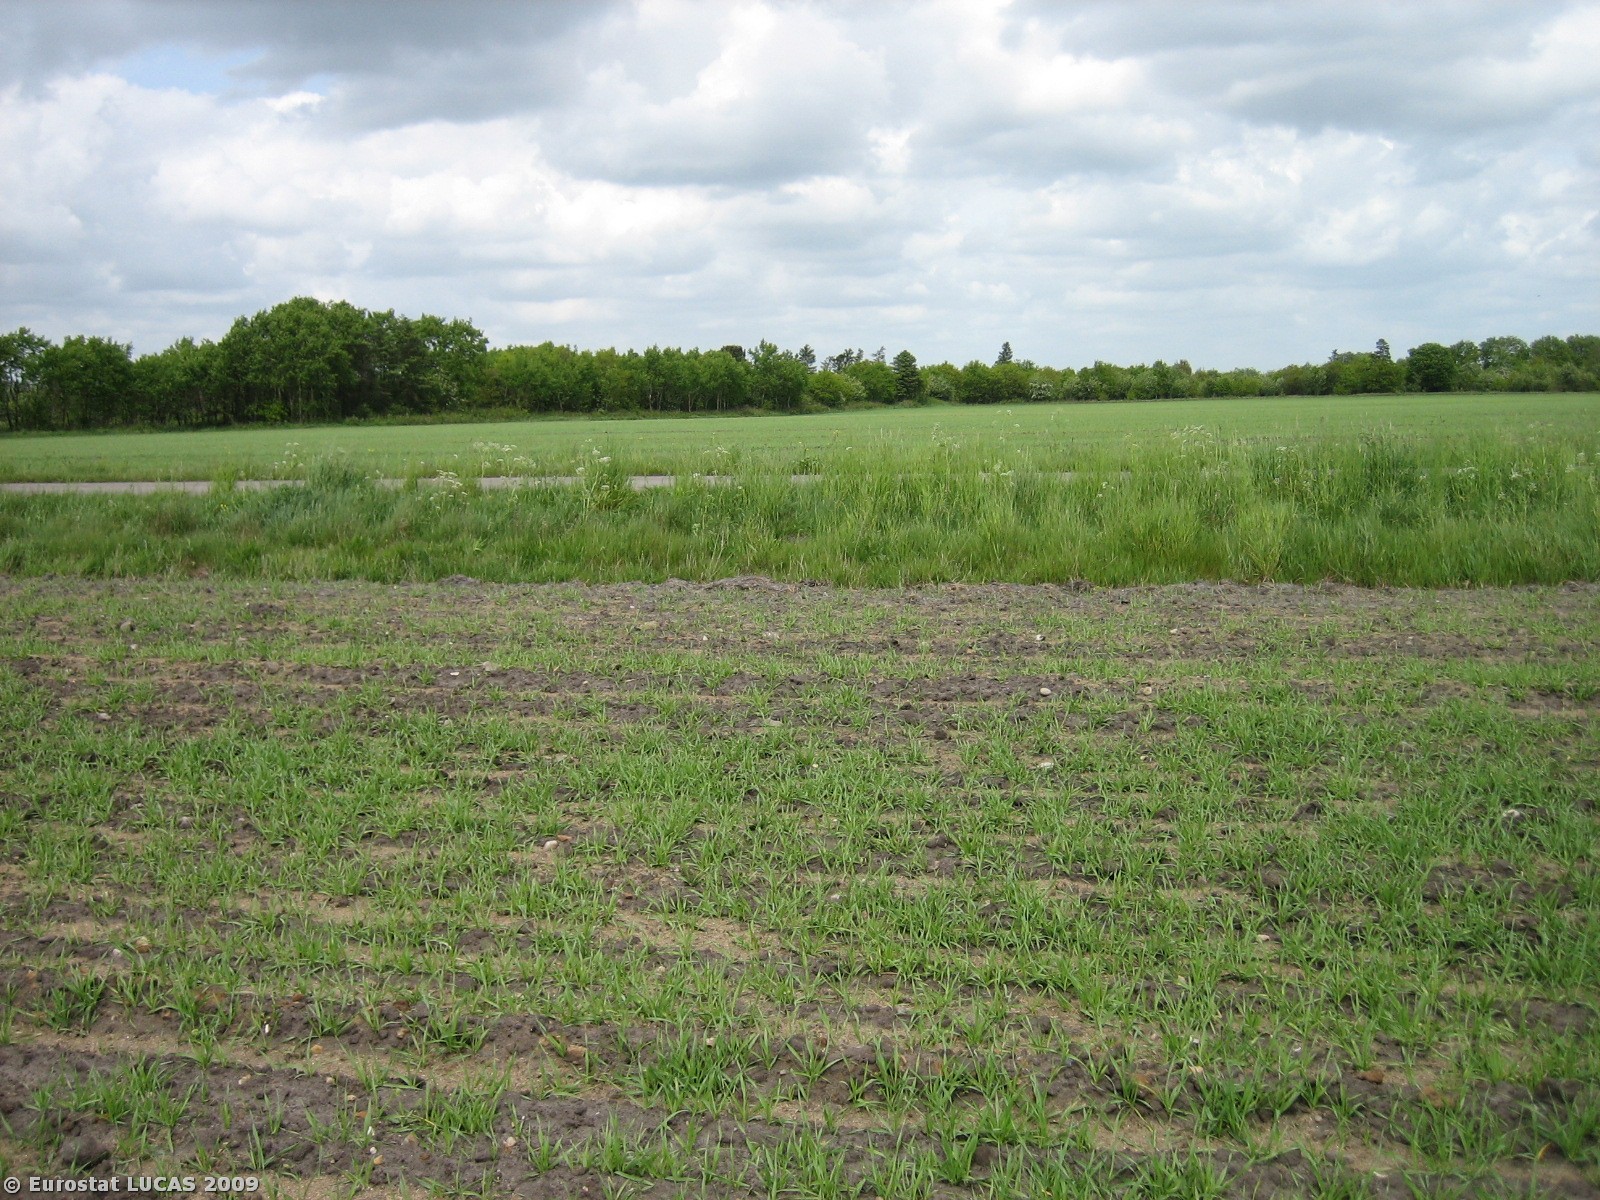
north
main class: Cropland
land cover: Barley
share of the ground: 50 - 75 %
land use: Agriculture (excluding fallow land and kitchen gardens)
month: May
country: DK
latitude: 56.1829
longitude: 8.8896
